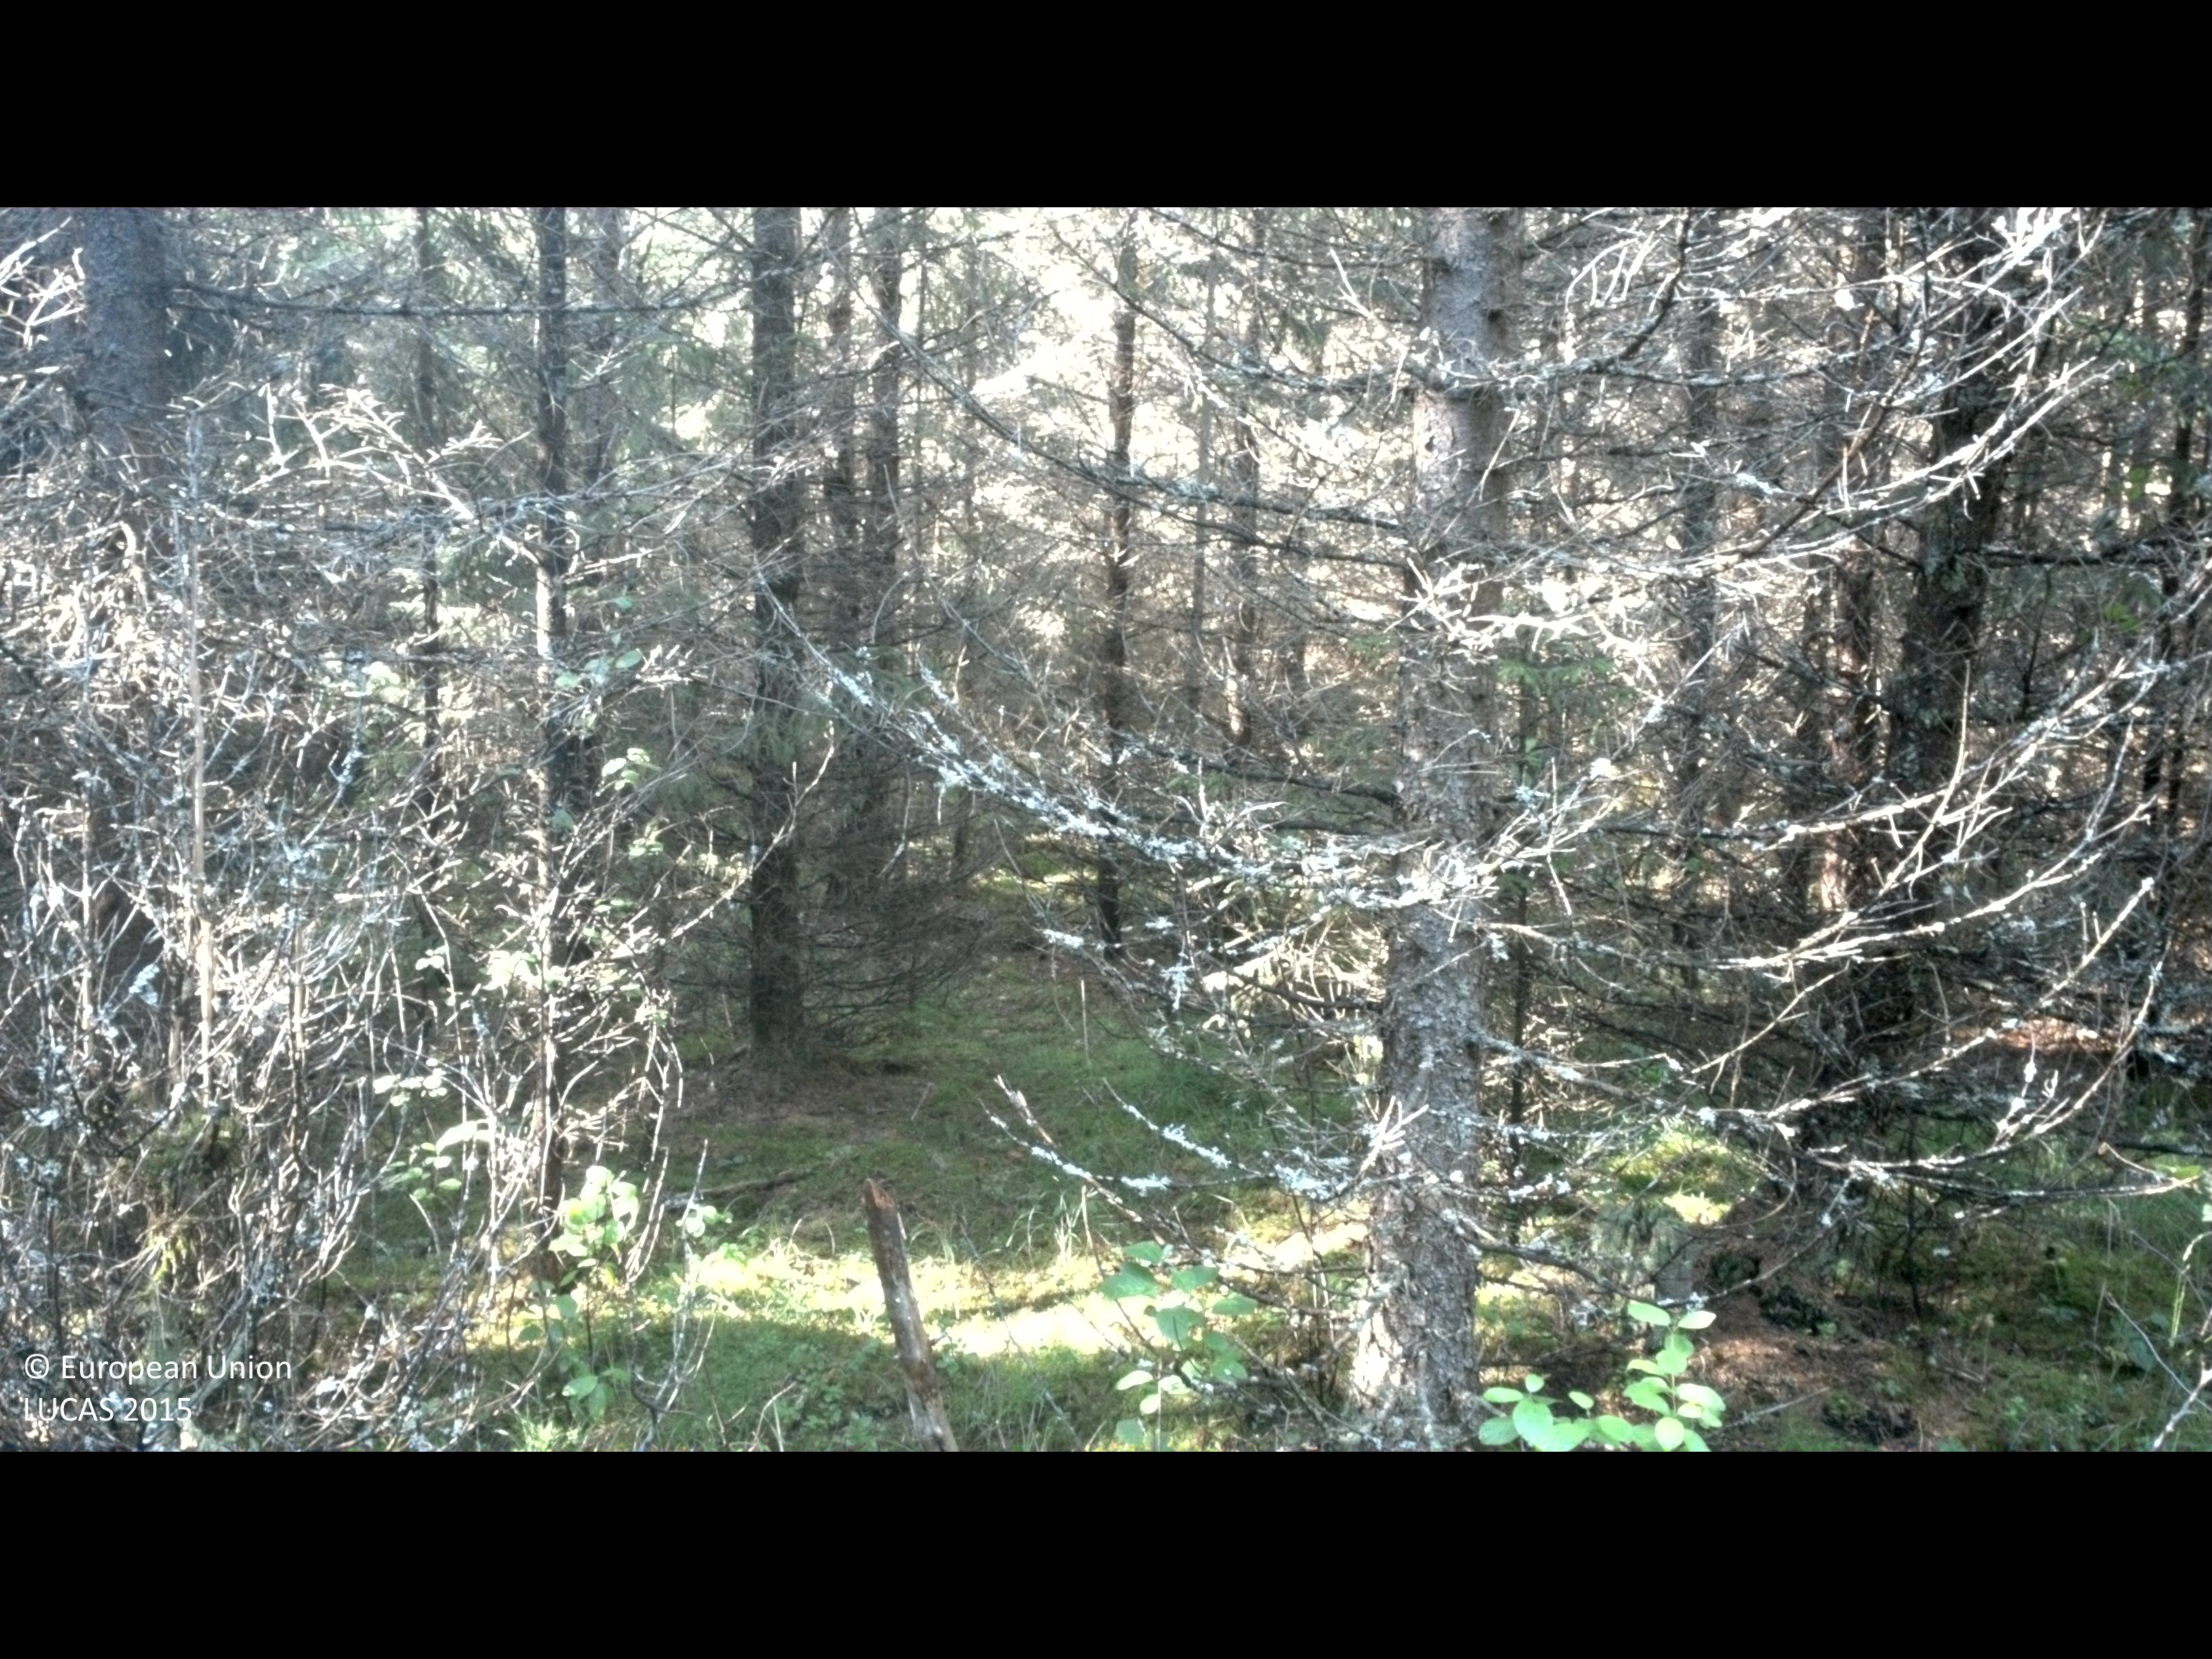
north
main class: Woodland
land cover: Spruce dominated coniferous woodland
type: boreal forest
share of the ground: > 75 %
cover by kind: coniferous forest trees 80 %, broadleaved forest trees 10 %, shrubs 5 %, herbaceous plants 5 %
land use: Forestry
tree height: > 5 m
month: July
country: SE
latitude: 58.4010
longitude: 16.2070
